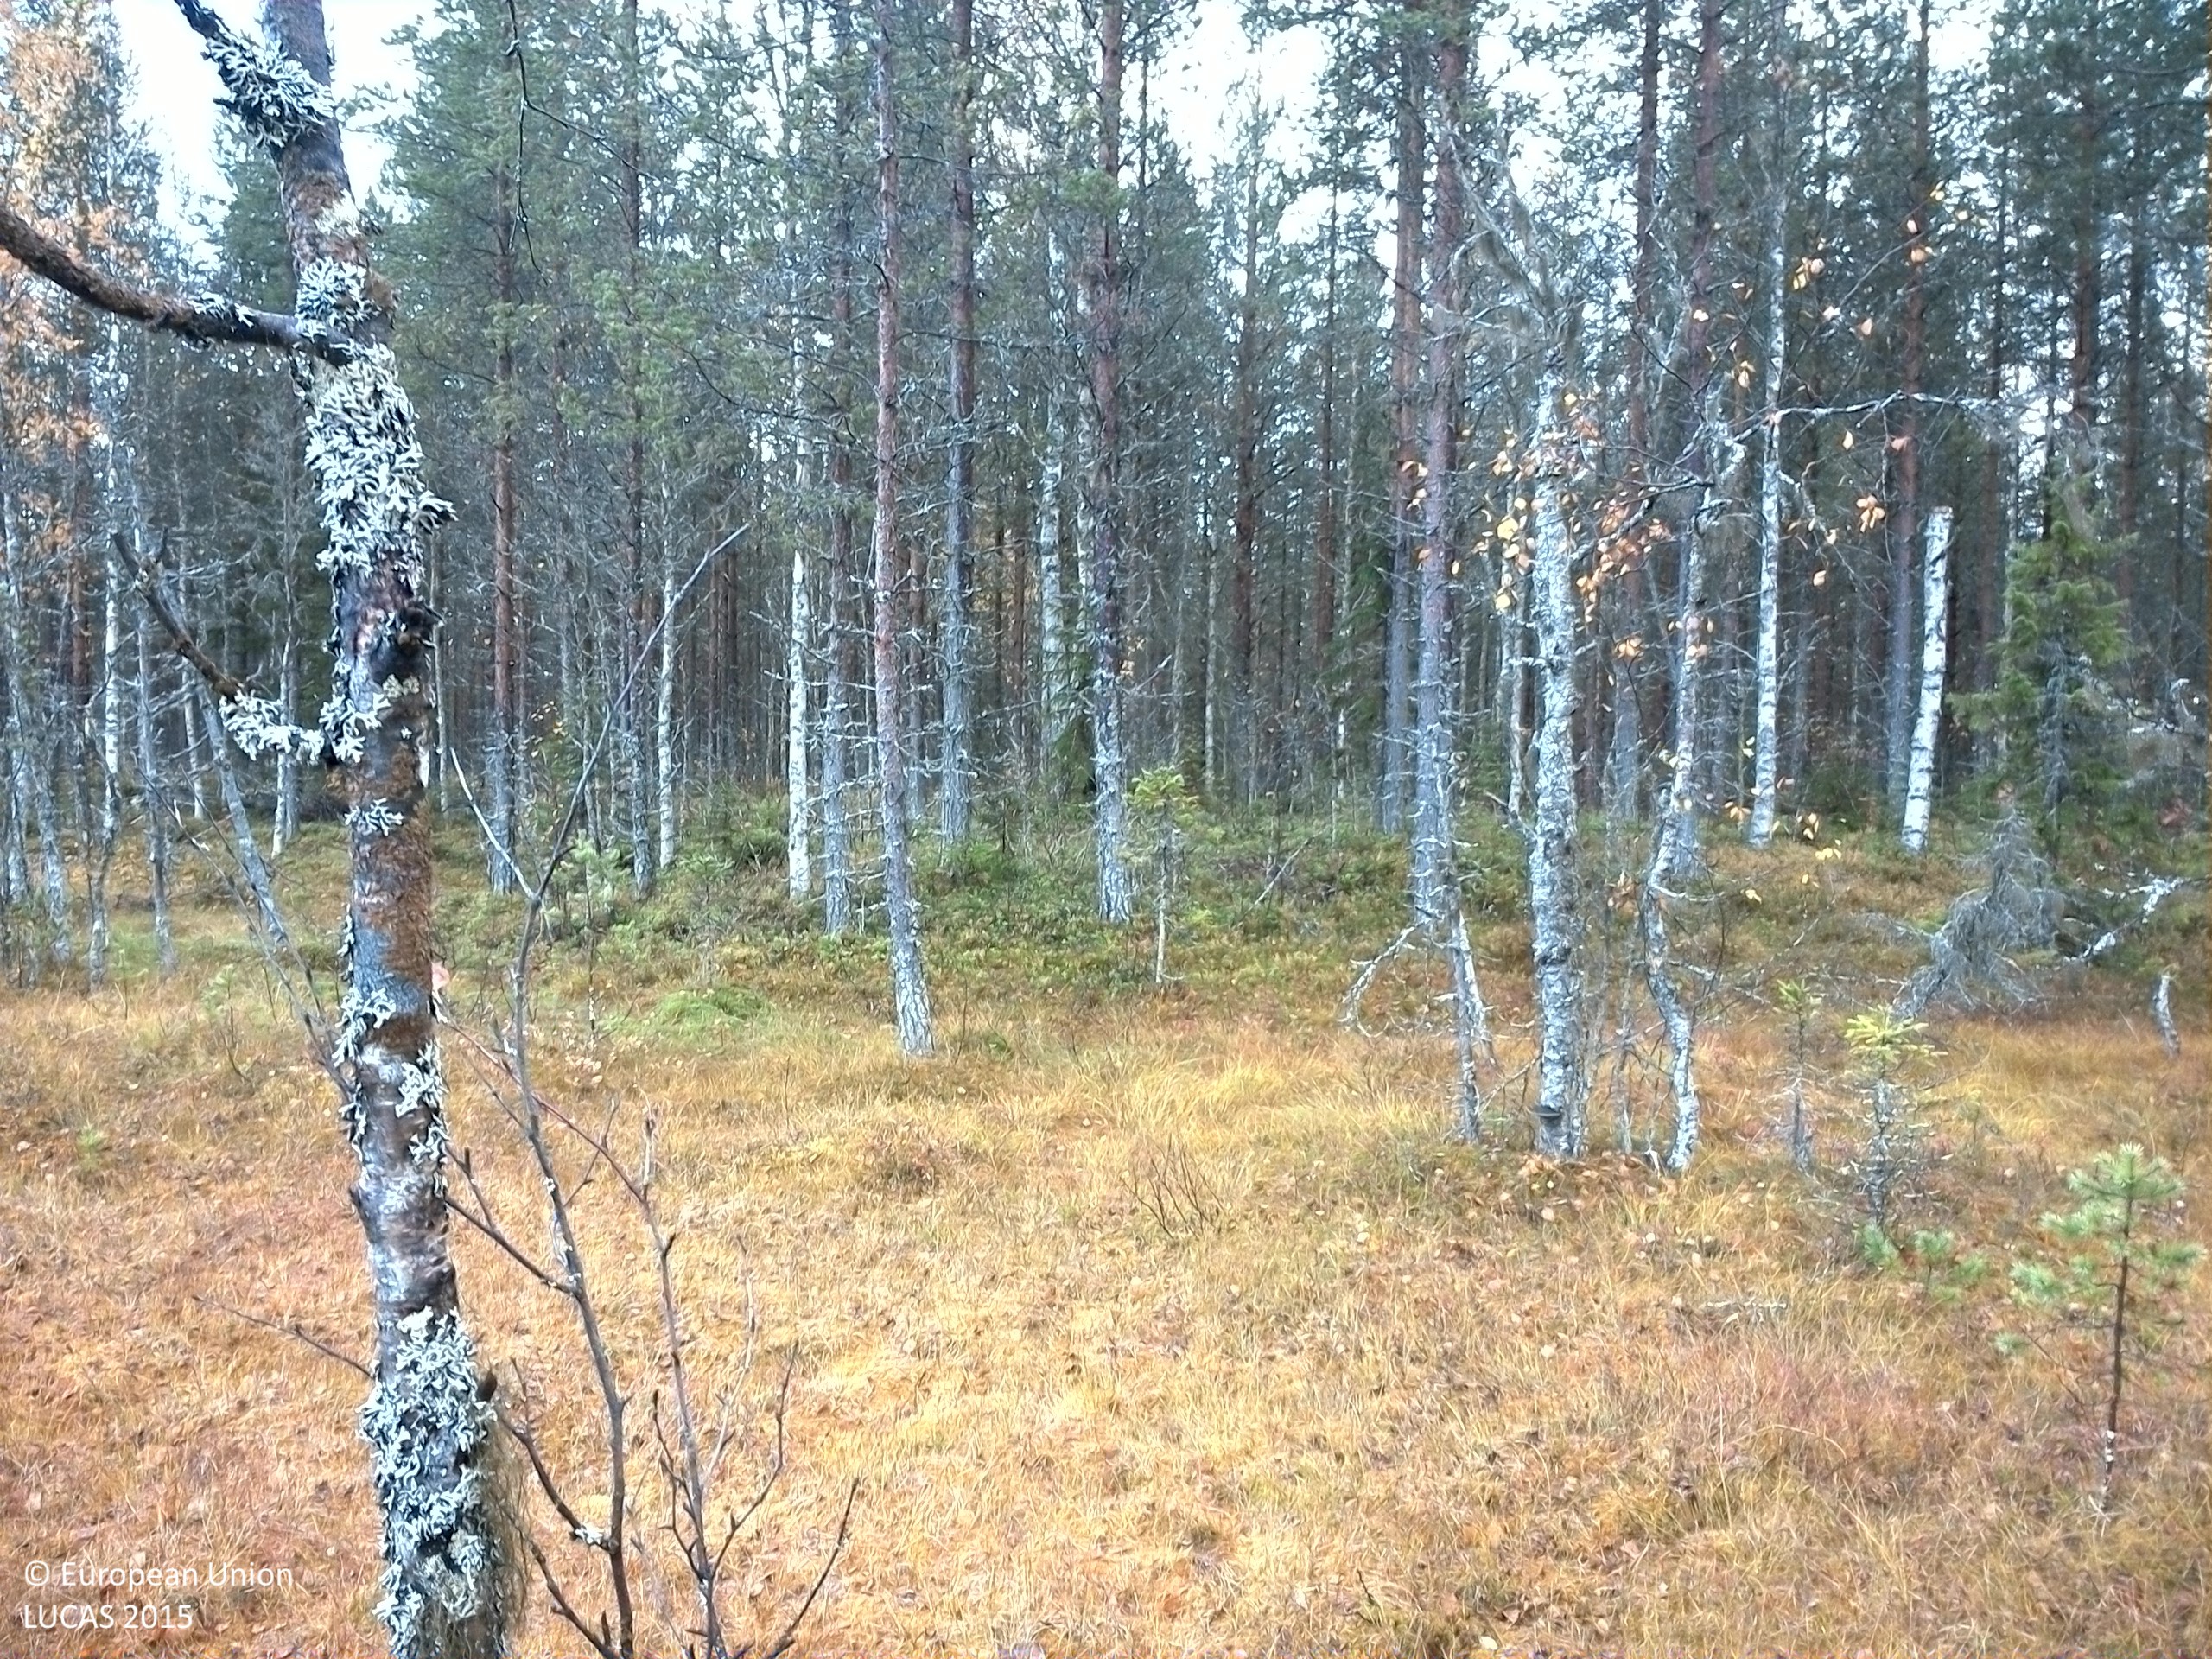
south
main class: Woodland
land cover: Pine dominated mixed woodland
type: mire and swamp forests
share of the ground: 10 - 25 %
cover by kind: herbaceous plants 35 %, lichens and mosses 35 %, coniferous forest trees 15 %, shrubs 10 %, broadleaved forest trees 5 %
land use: Semi-natural and natural areas not in use
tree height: > 5 m
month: October
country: SE
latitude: 64.0503
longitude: 15.9728
